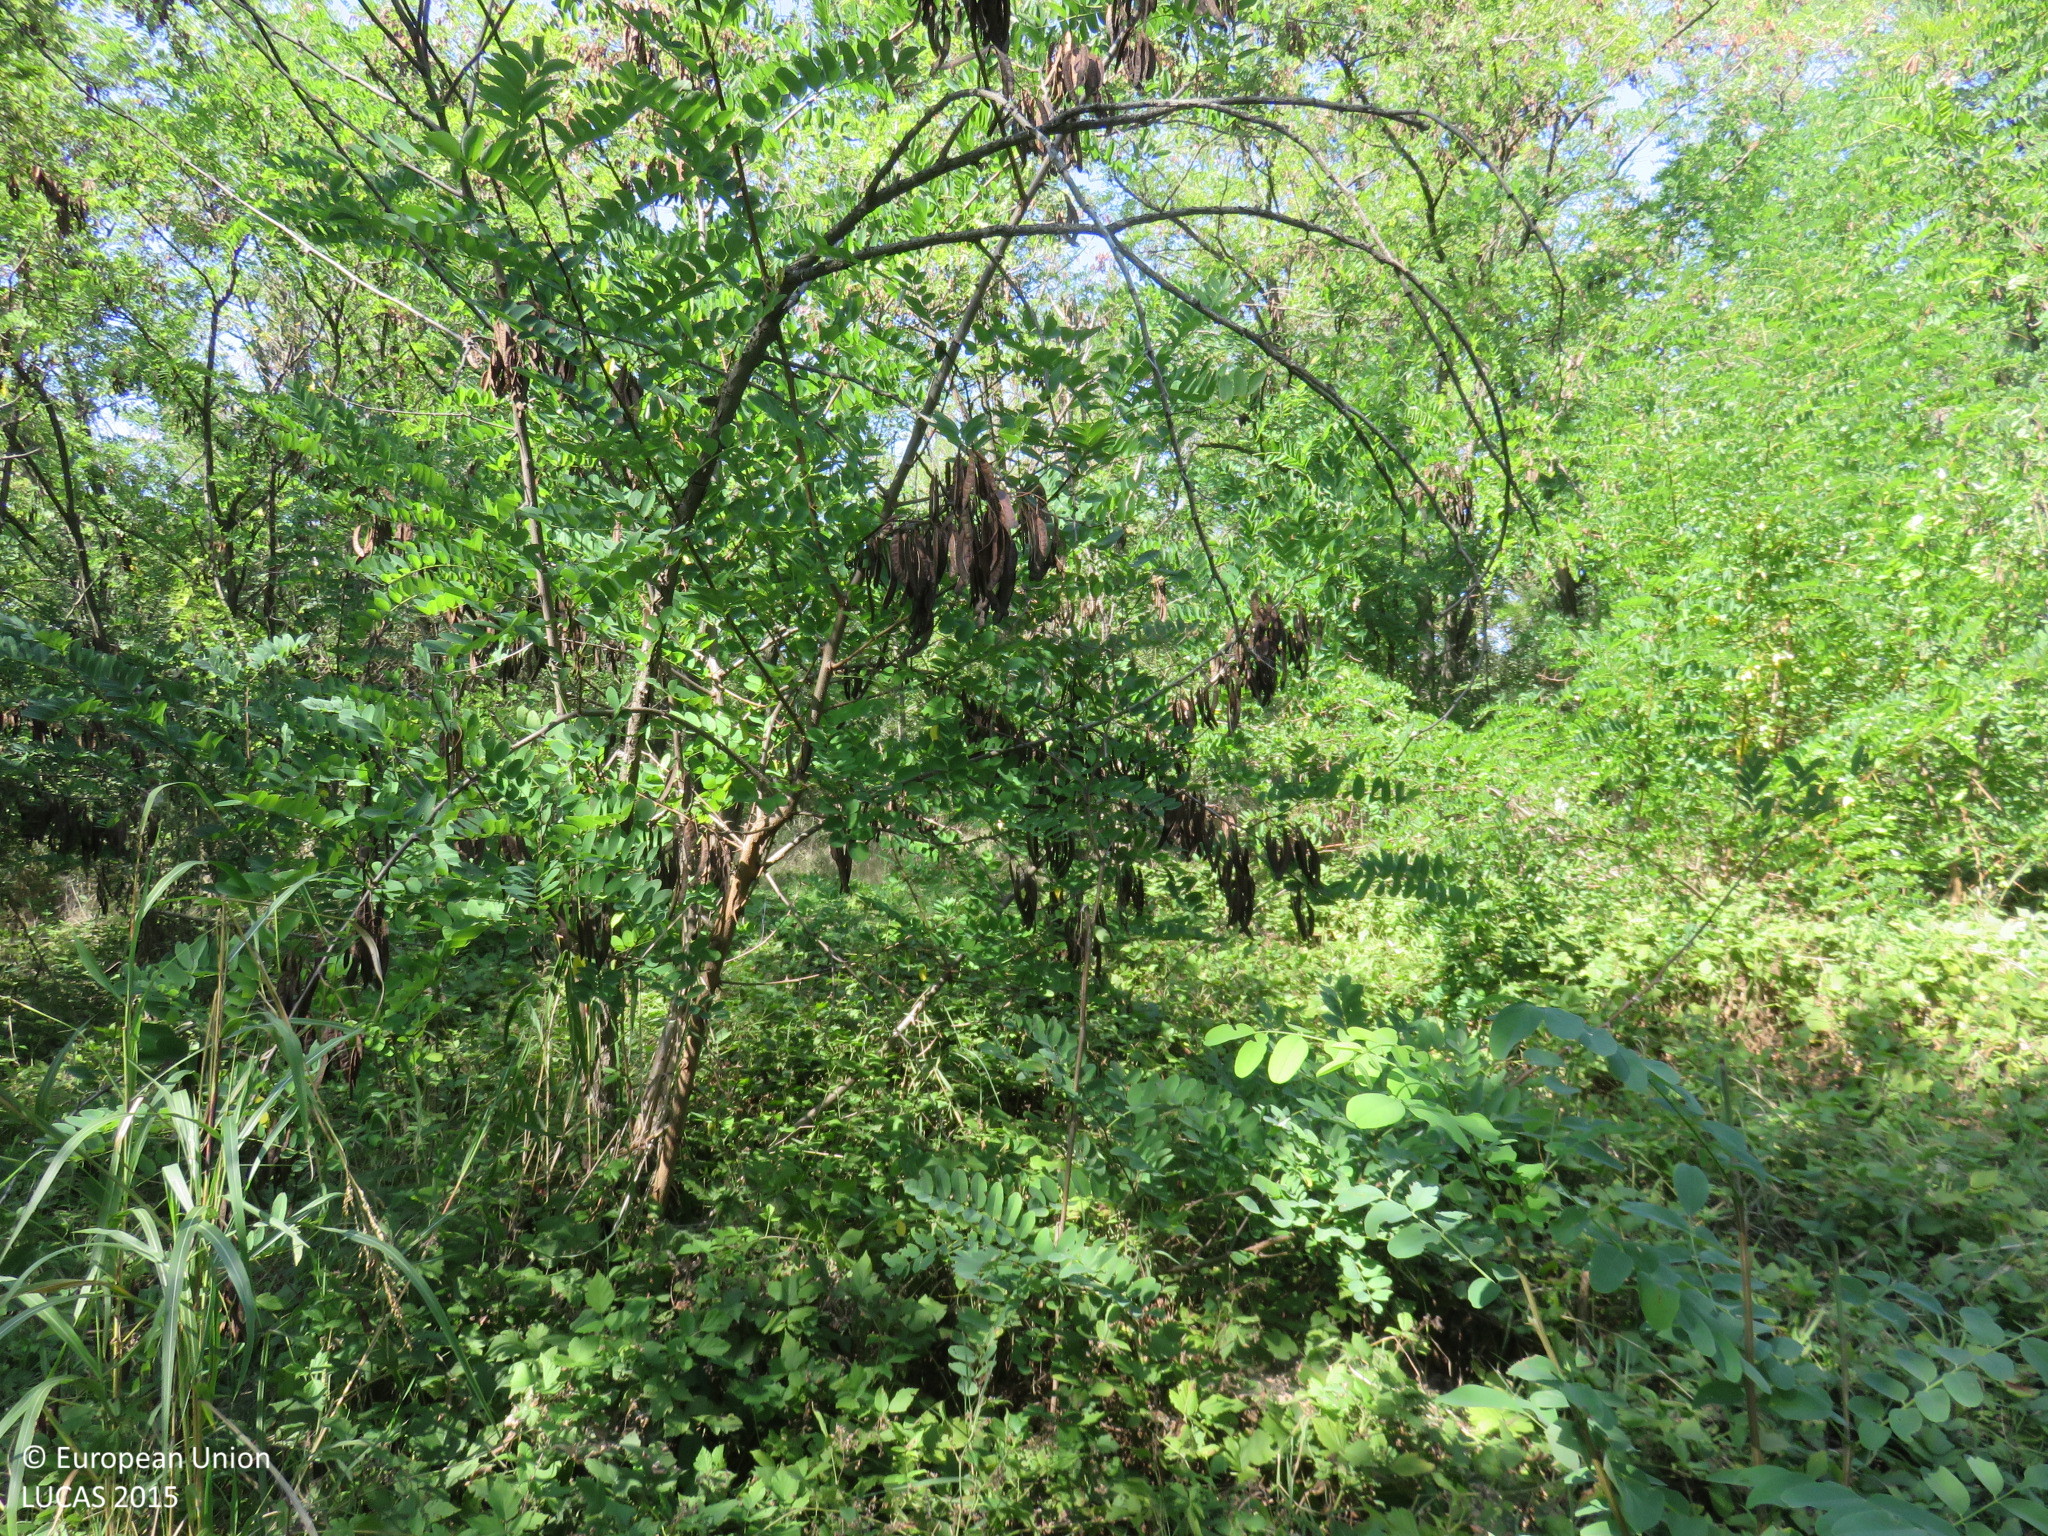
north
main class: Woodland
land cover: Broadleaved woodland
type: mesophytic deciduous forest
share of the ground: > 75 %
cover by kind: broadleaved forest trees 85 %, shrubs 10 %, herbaceous plants 5 %
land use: Forestry
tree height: < 5 m
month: September
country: BG
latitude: 43.6399
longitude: 24.4793
